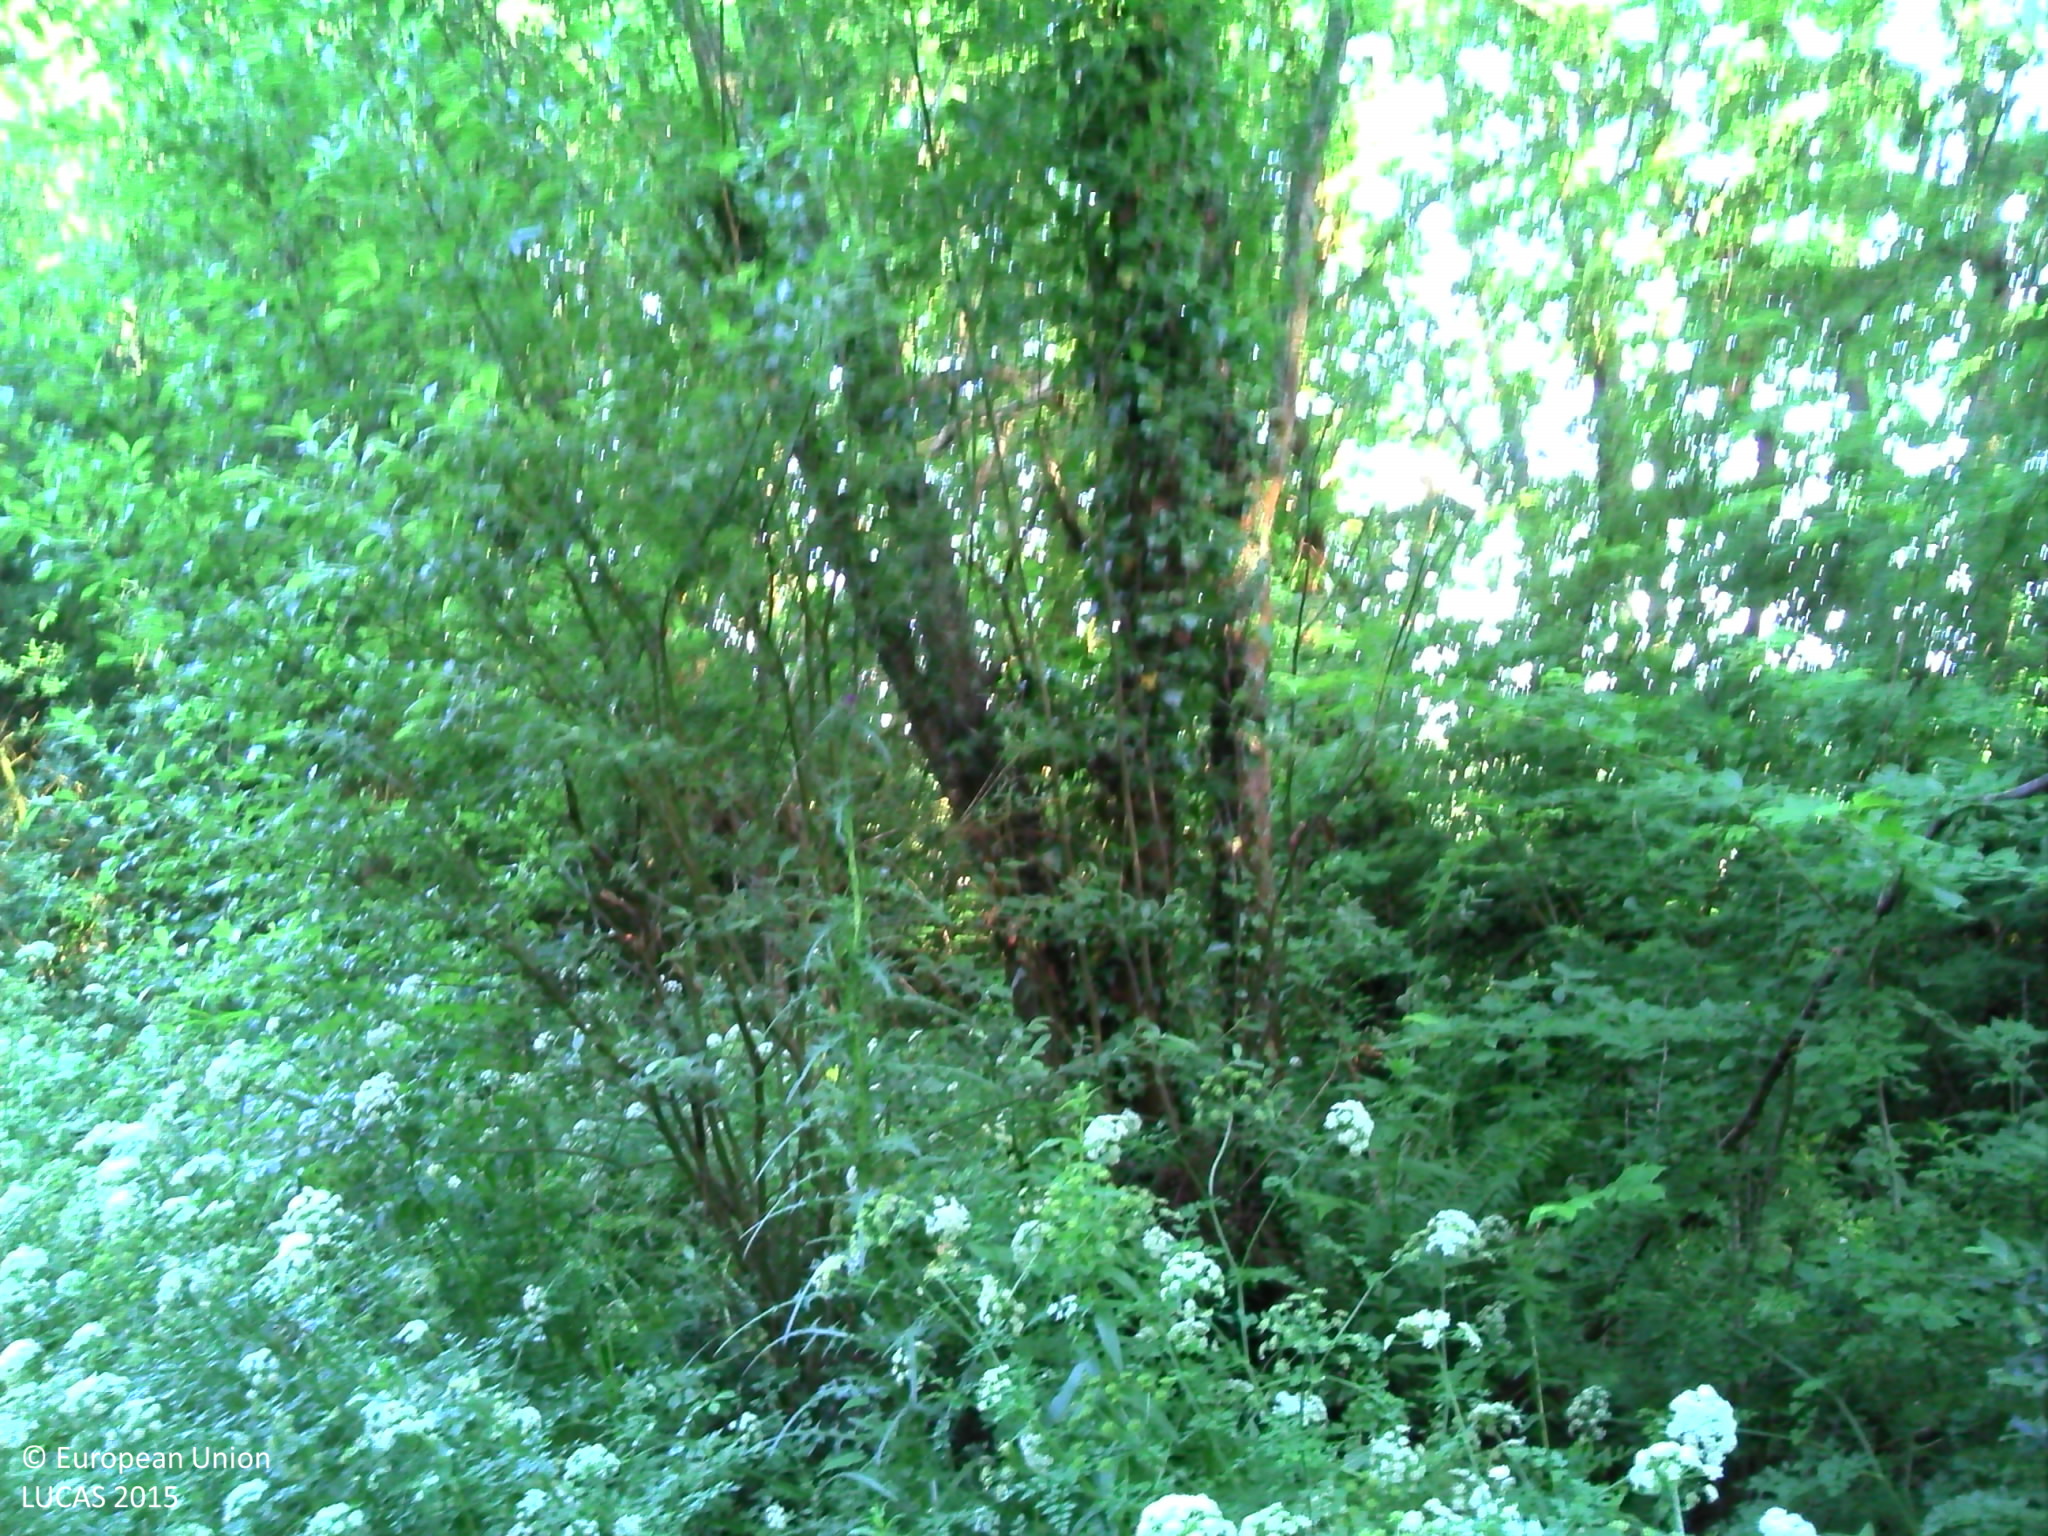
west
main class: Woodland
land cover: Broadleaved woodland
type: acidophilous oak and oak-birch forest
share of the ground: > 75 %
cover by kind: broadleaved forest trees 85 %, herbaceous plants 10 %, shrubs 5 %
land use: Forestry
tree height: > 5 m
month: June
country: FR
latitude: 49.1818
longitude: -1.5042
